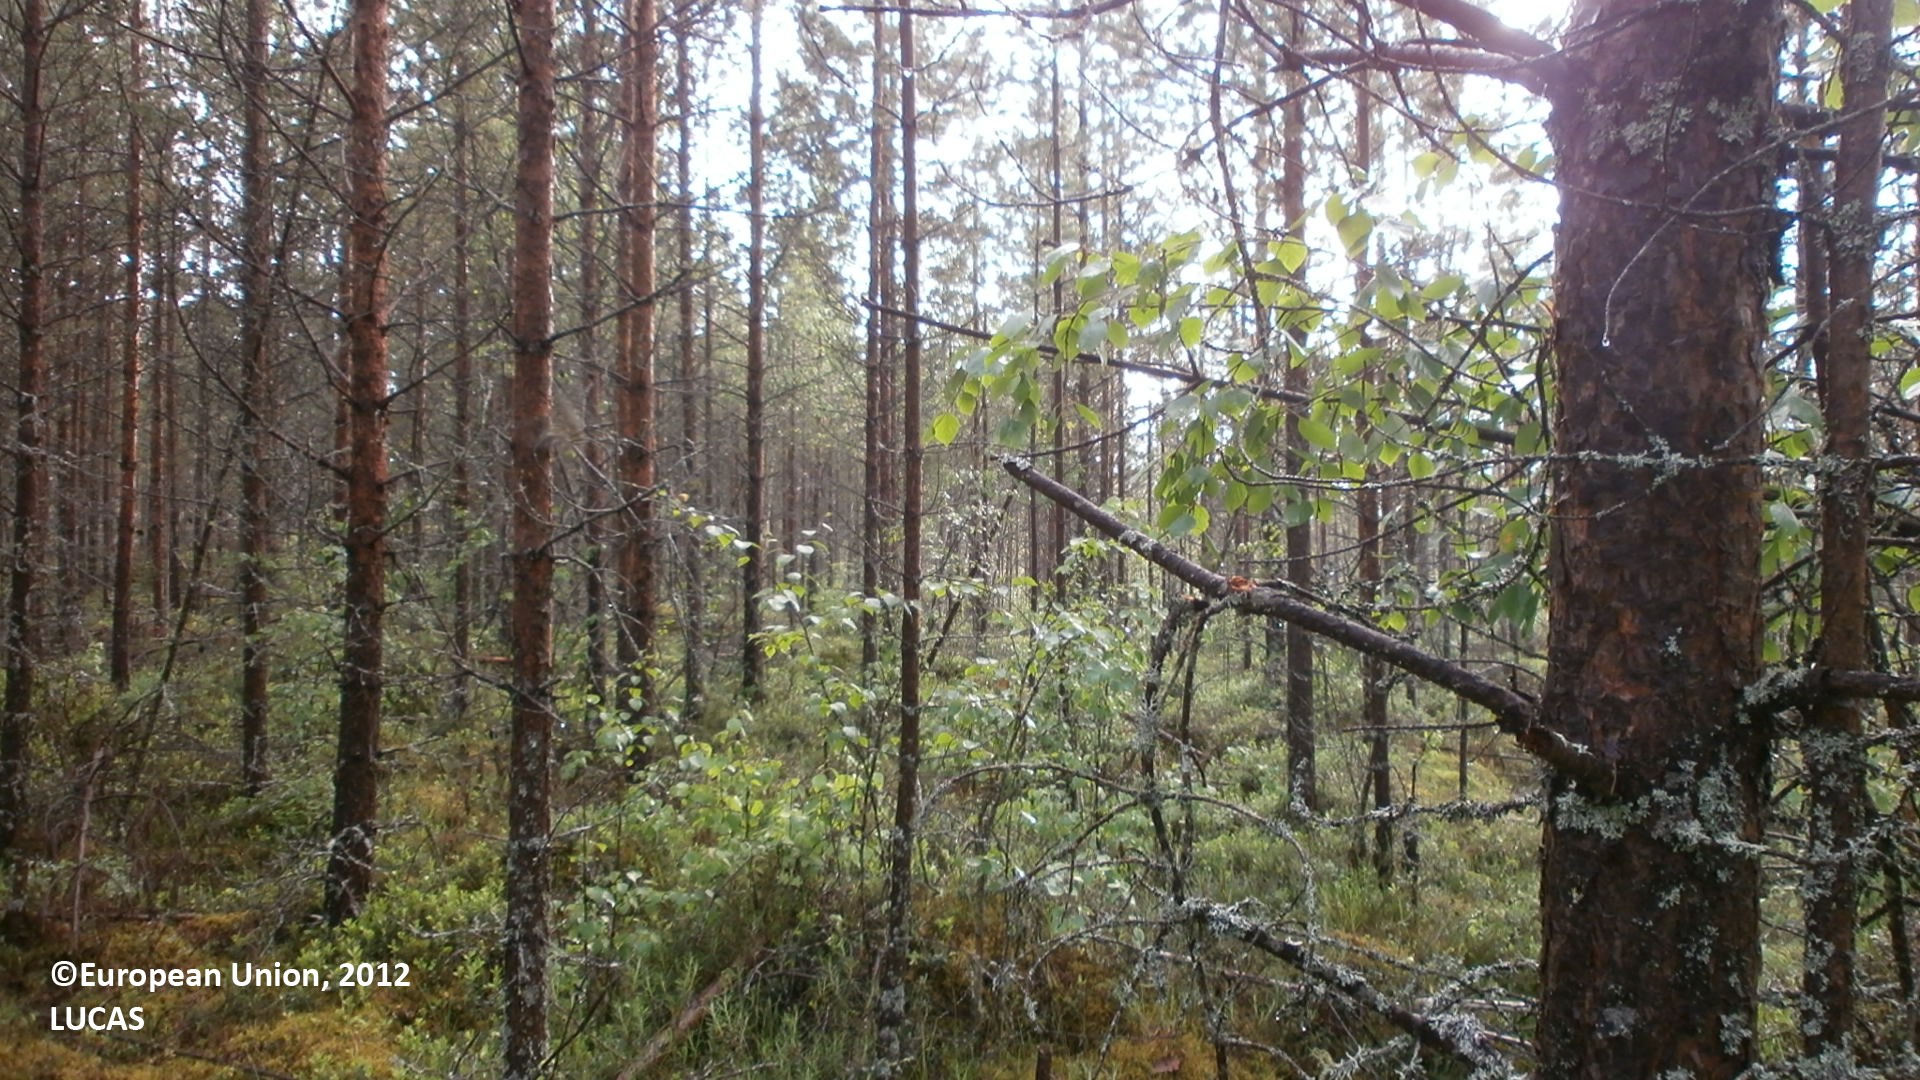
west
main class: Woodland
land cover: Pine dominated coniferous woodland
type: mire and swamp forests
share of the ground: 50 - 75 %
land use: Forestry
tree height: > 5 m
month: June
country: FI
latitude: 64.8075
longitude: 25.1758
